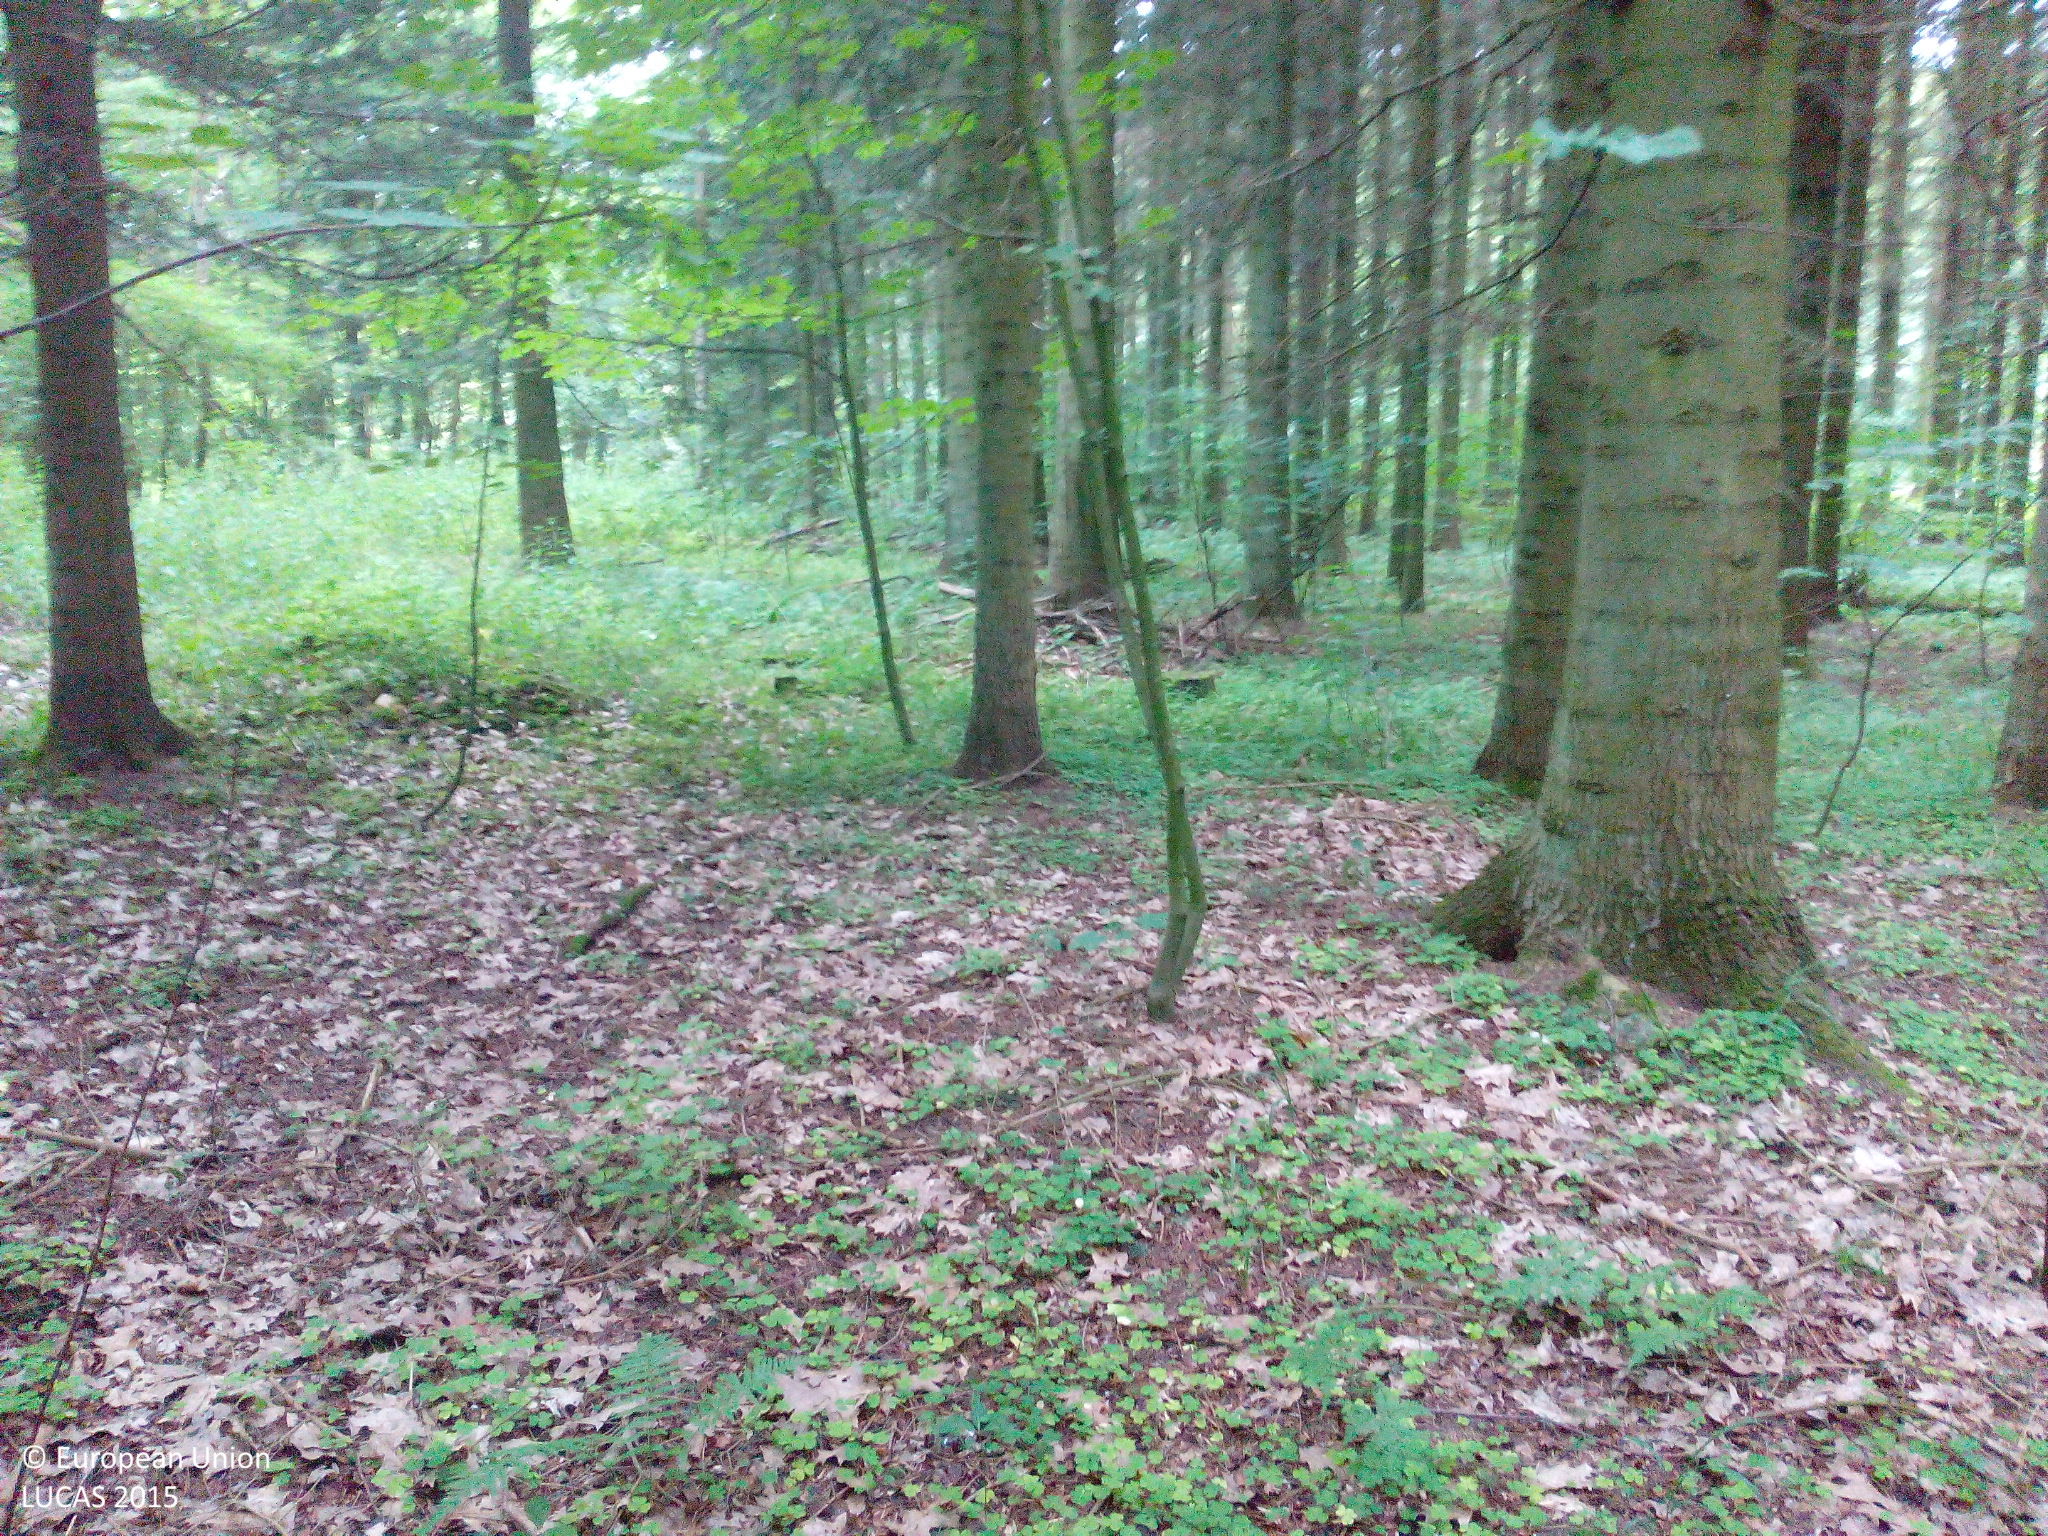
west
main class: Woodland
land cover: Other coniferous woodland
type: acidophilous oak and oak-birch forest
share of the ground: > 75 %
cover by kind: coniferous forest trees 70 %, broadleaved forest trees 20 %, herbaceous plants 5 %, unconsolidated bare surface 5 %
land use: Forestry
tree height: > 5 m
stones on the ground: 10 - 25 %
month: August
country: DK
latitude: 55.5451
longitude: 11.8527
